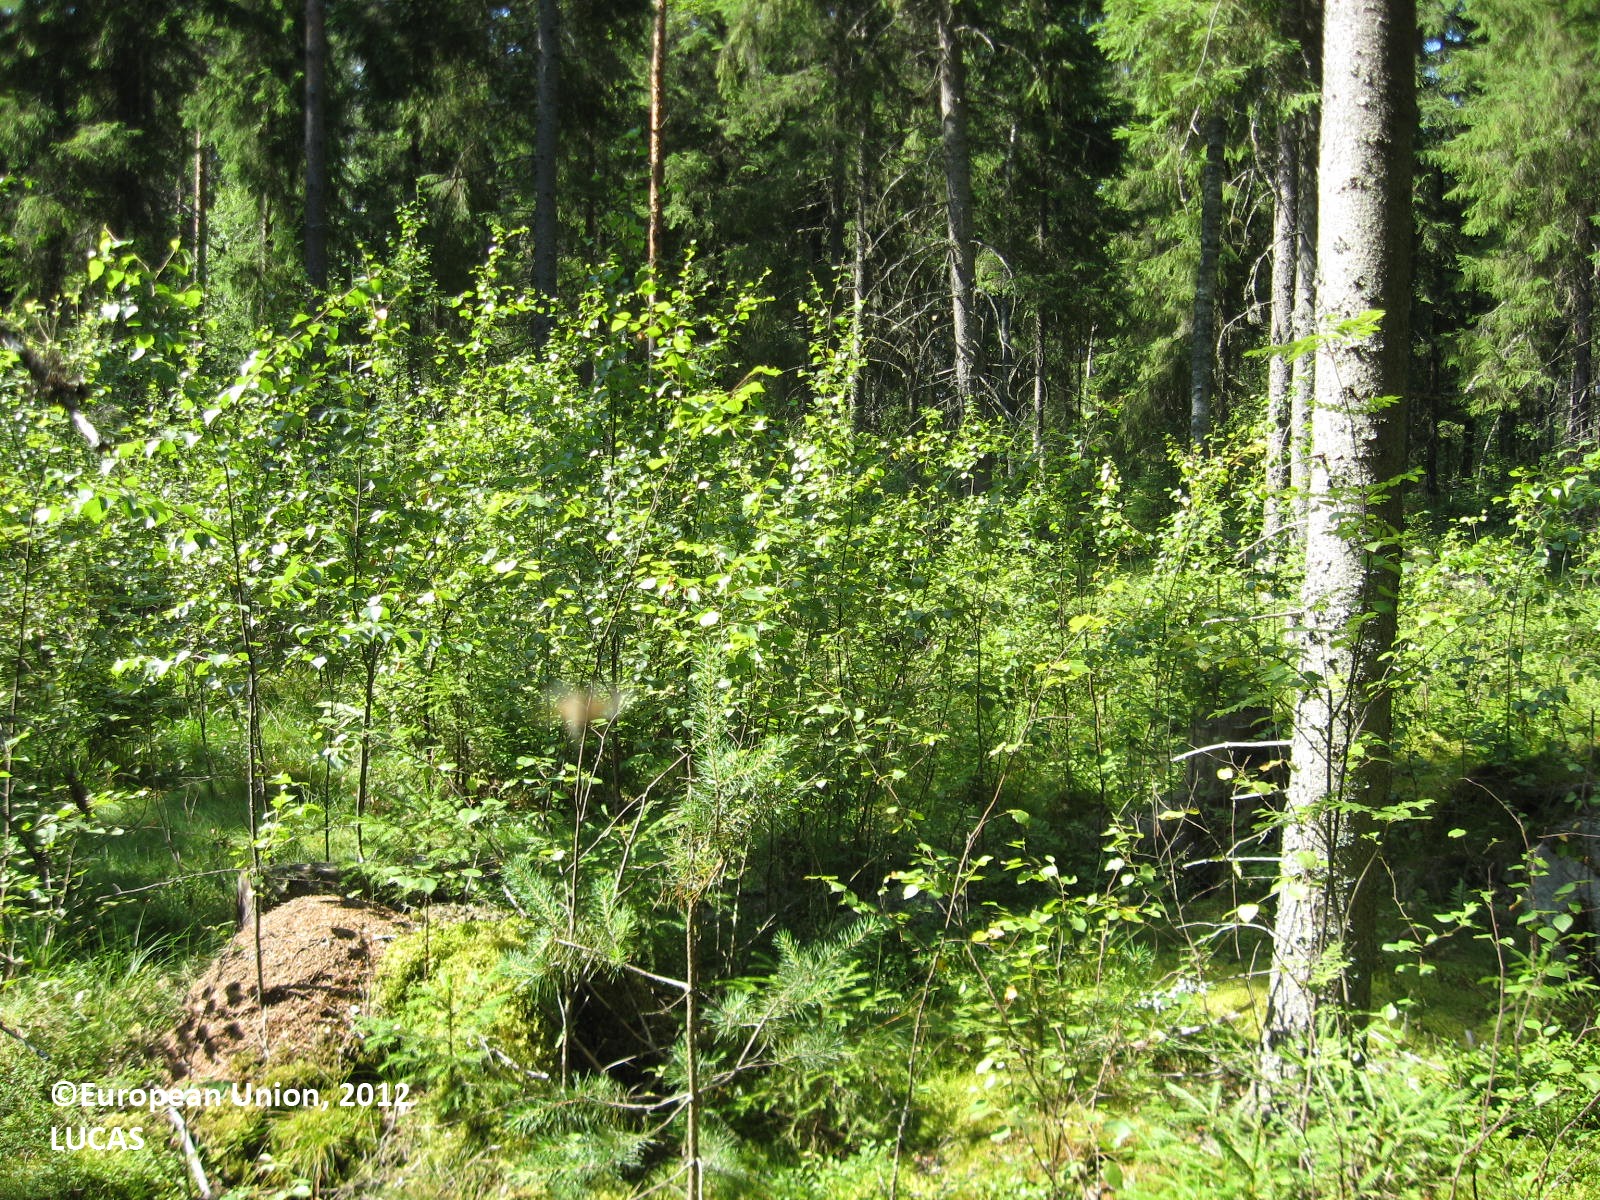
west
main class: Woodland
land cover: Spruce dominated coniferous woodland
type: boreal forest
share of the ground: > 75 %
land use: Forestry
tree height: > 5 m
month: July
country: FI
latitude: 61.9630
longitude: 22.9004
